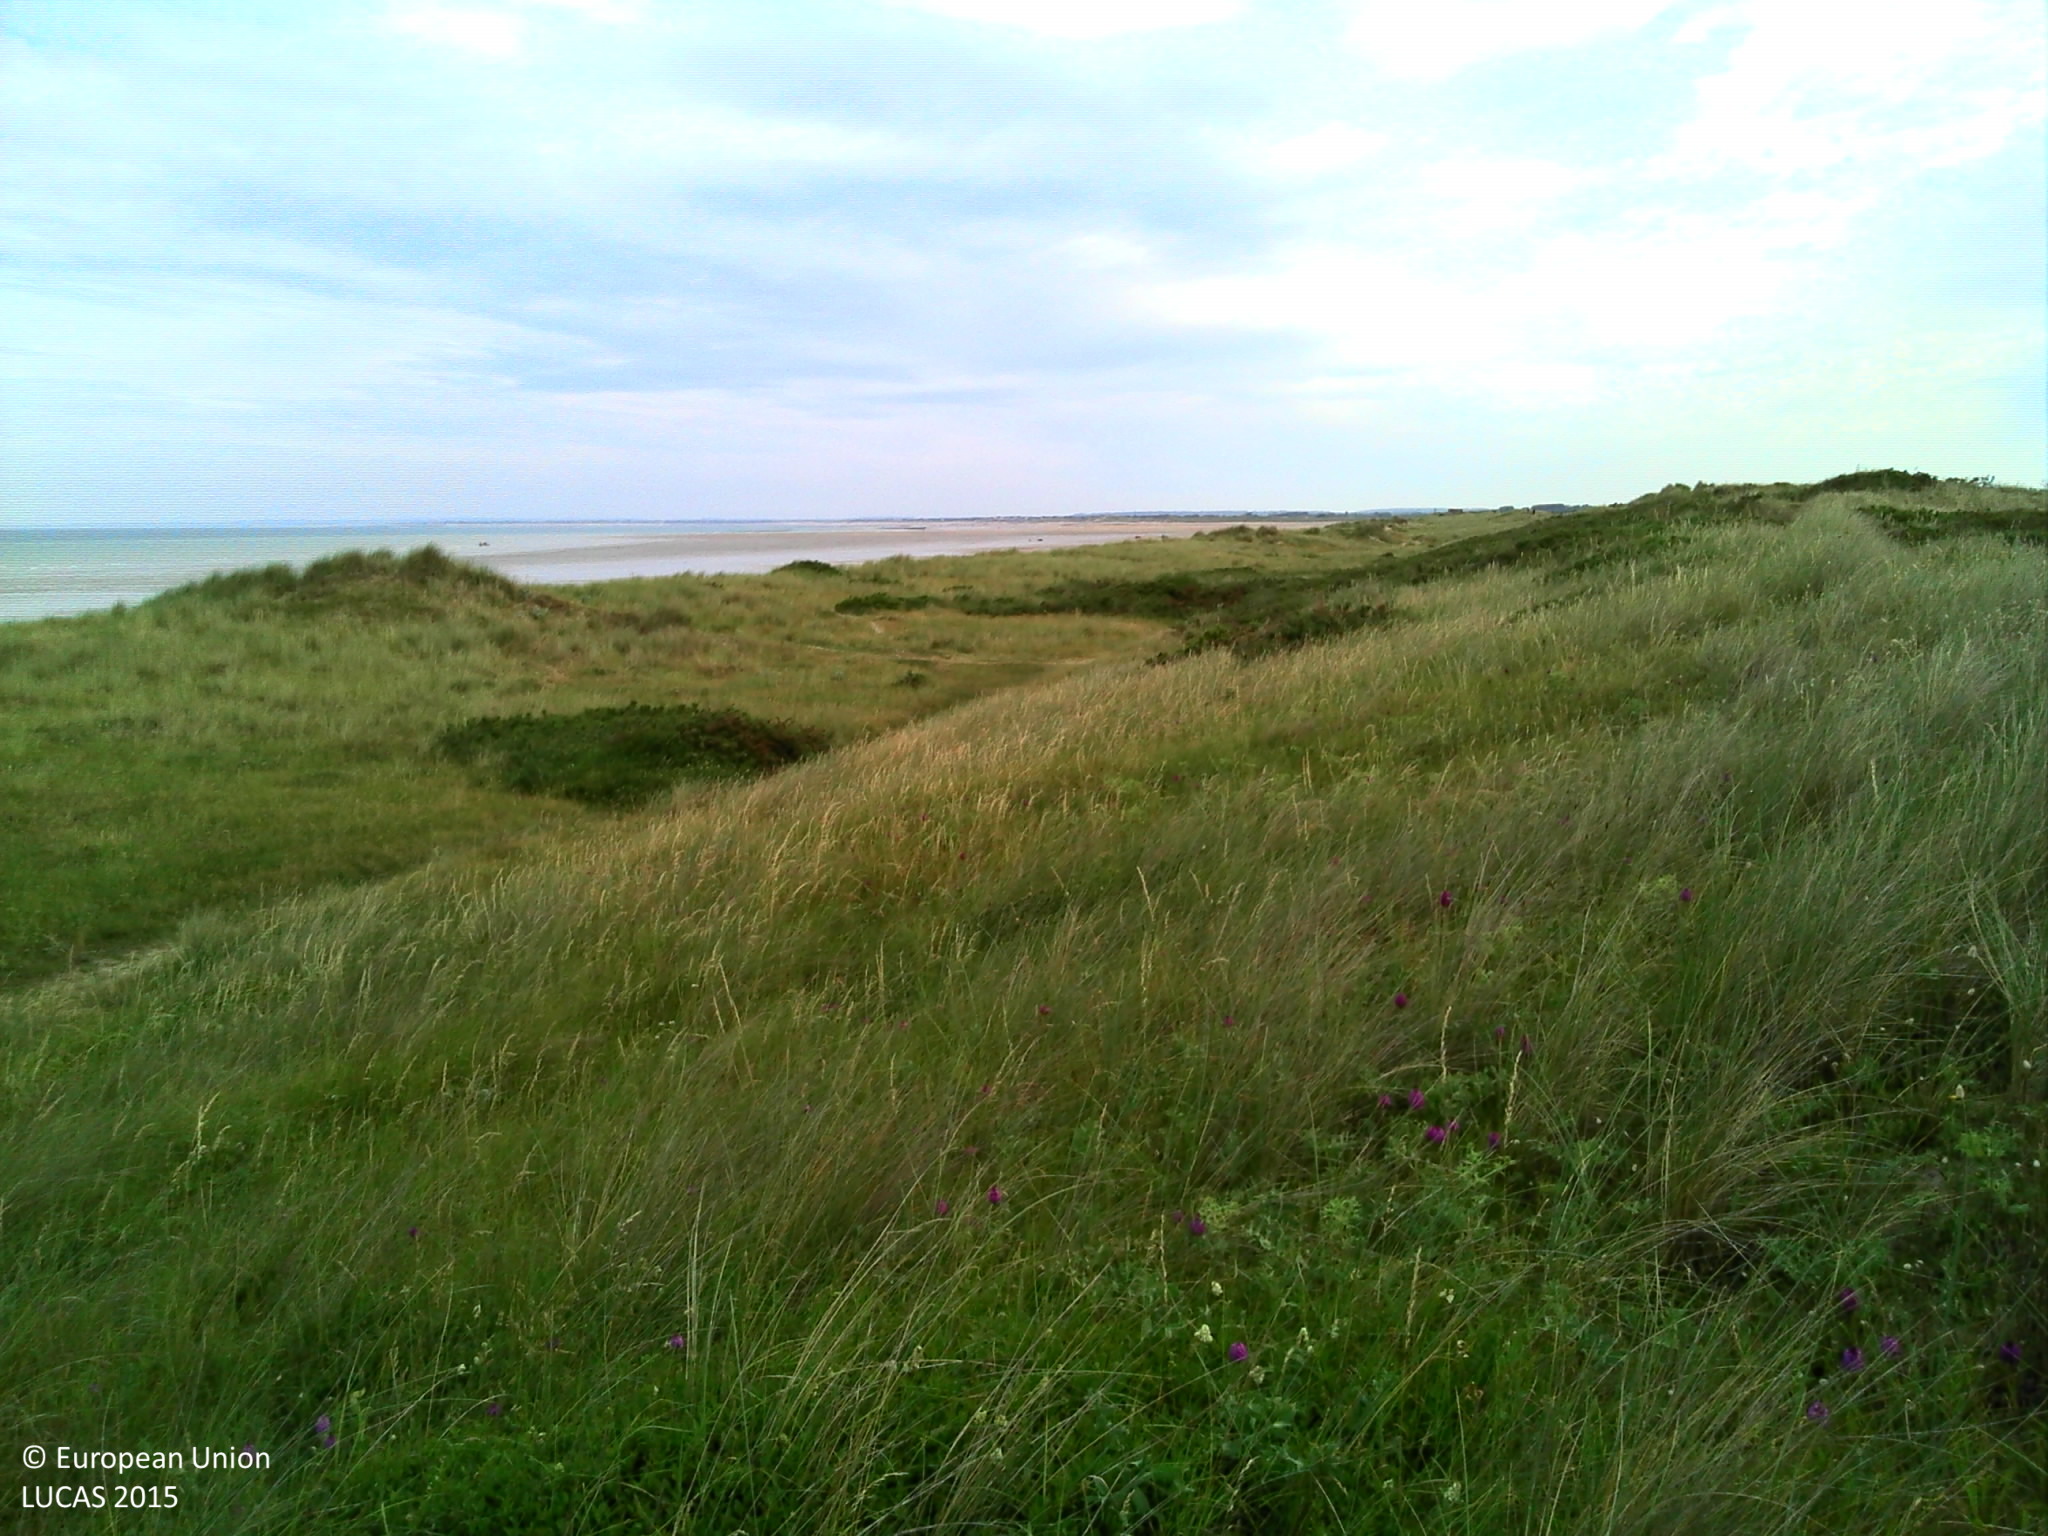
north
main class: Shrubland
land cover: Shrubland without tree cover
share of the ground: > 75 %
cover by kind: unconsolidated bare surface 70 %, herbaceous plants 20 %, shrubs 10 %
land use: Semi-natural and natural areas not in use
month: June
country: FR
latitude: 49.1174
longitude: -1.6001
